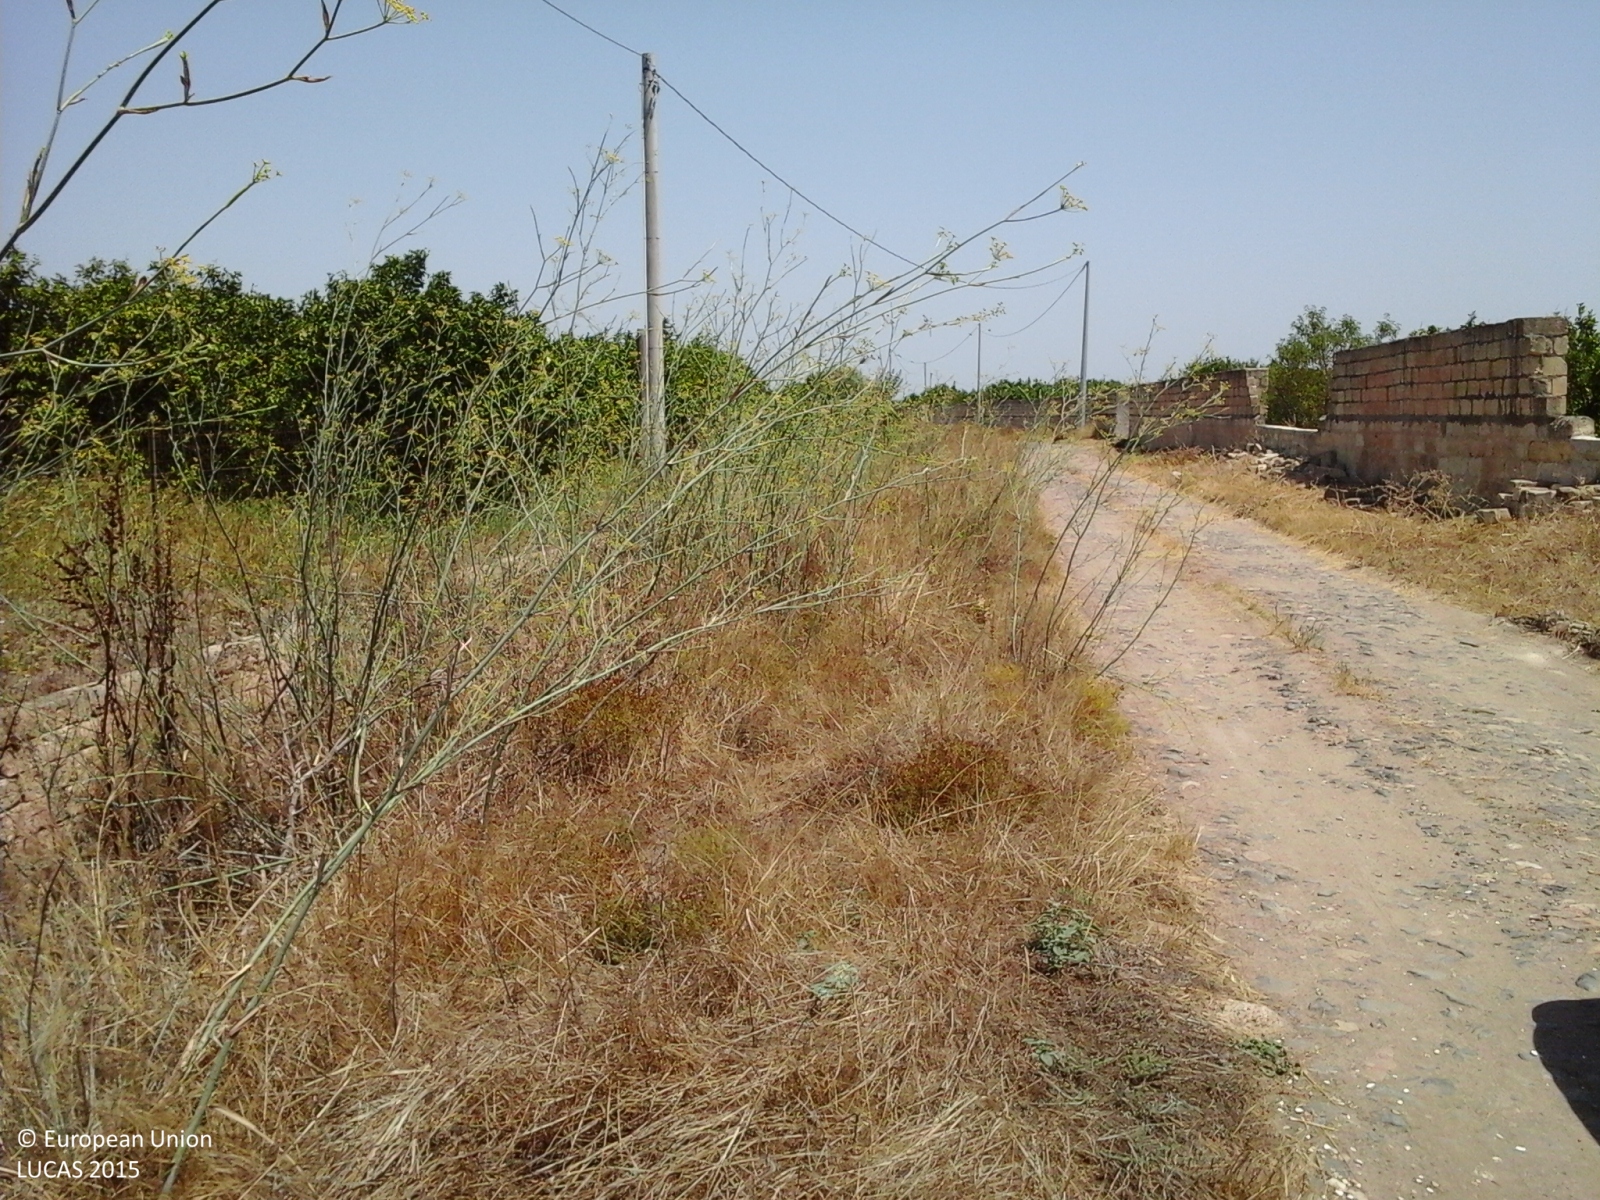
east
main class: Cropland
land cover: Oranges
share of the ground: > 75 %
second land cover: Spontaneously vegetated surfaces
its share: > 75 %
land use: Agriculture (excluding fallow land and kitchen gardens)
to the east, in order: Oranges; Spontaneously vegetated surfaces; Grass margins; Ditches and canals; Grass margins; Tracks; Oranges
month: August
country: IT
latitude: 37.3123
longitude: 14.8944
